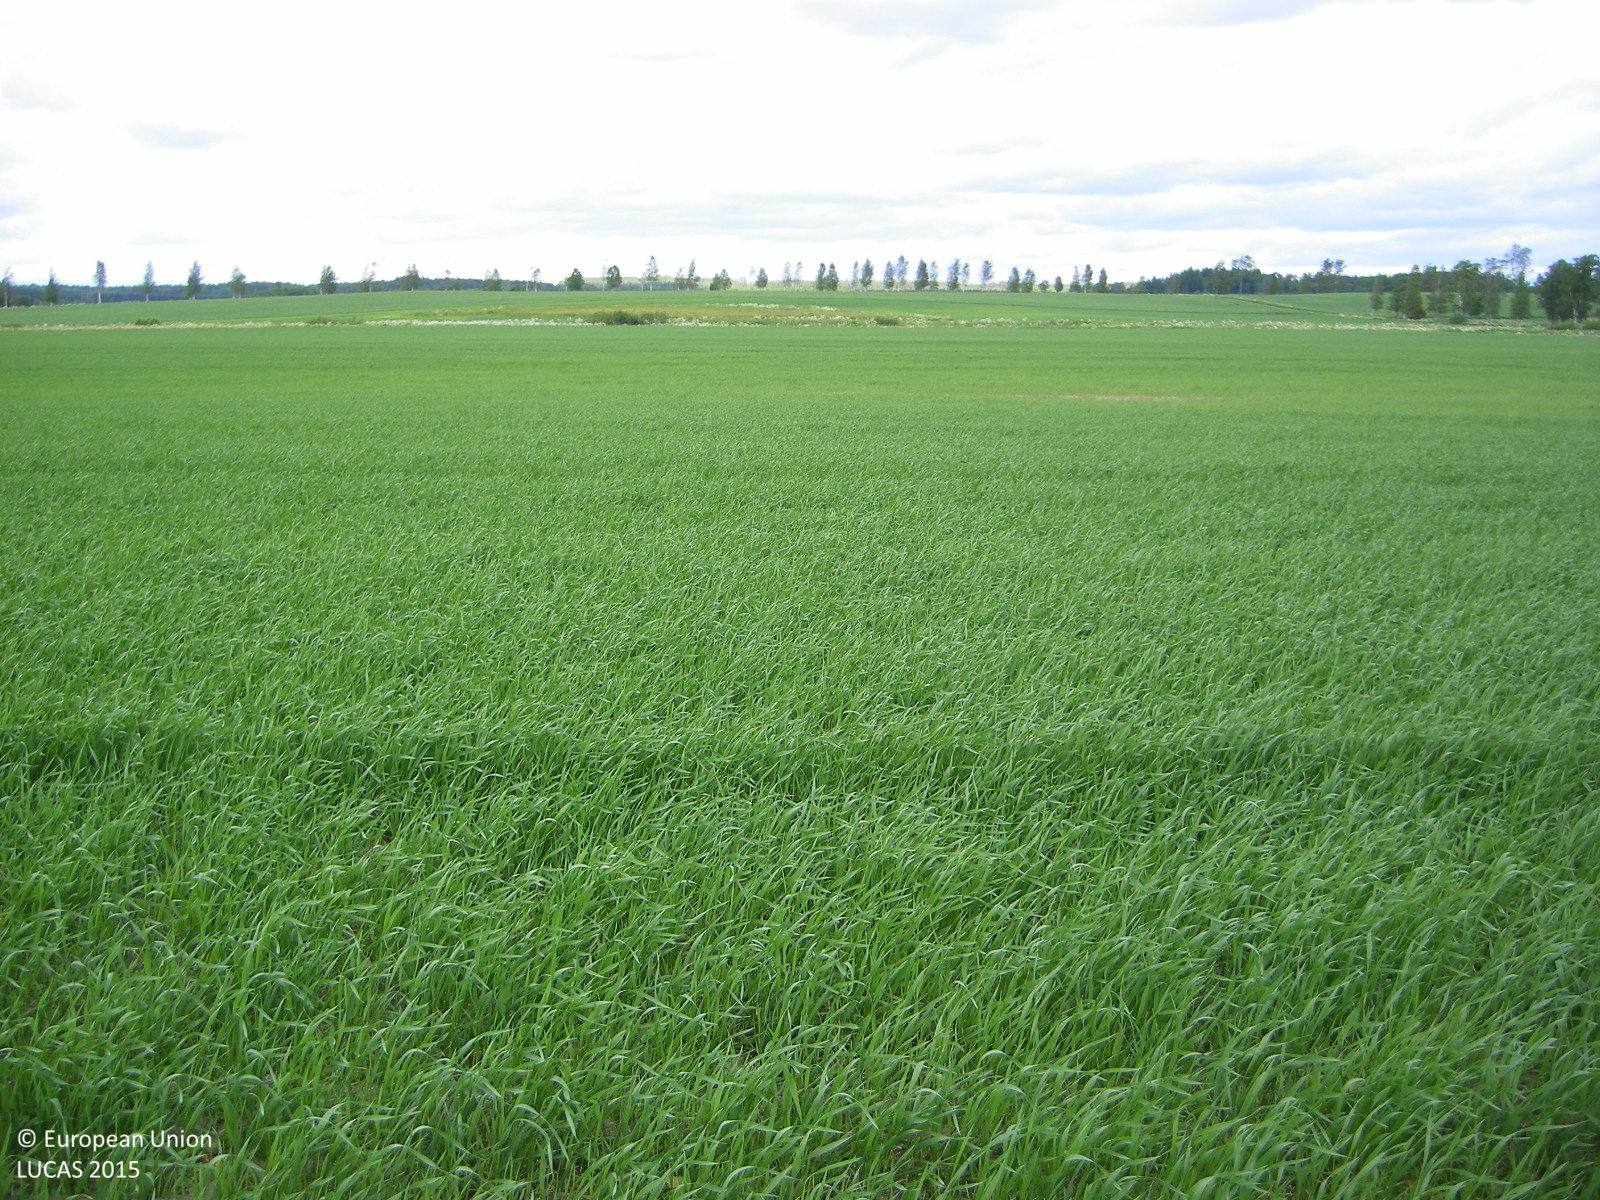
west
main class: Cropland
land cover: Common wheat
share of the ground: > 75 %
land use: Agriculture (excluding fallow land and kitchen gardens)
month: June
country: FI
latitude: 60.1850
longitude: 24.0737
